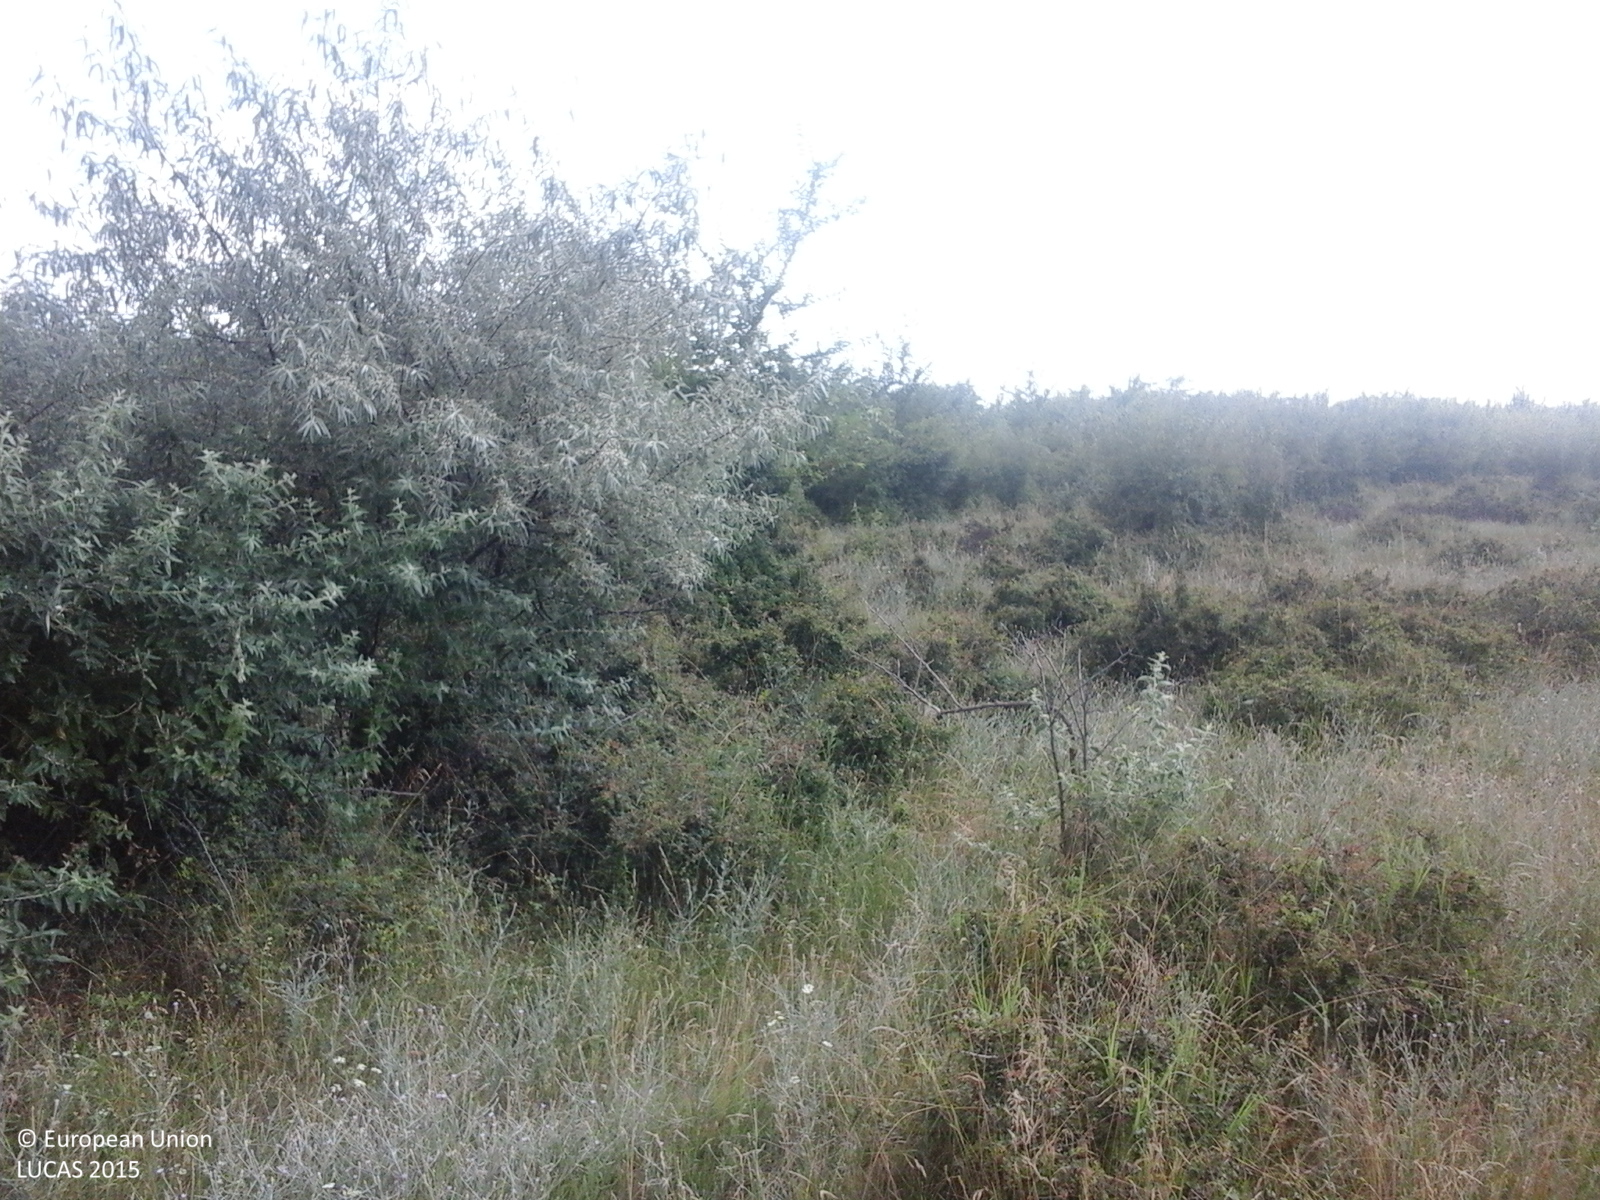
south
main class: Shrubland
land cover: Shrubland with sparse tree cover
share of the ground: > 75 %
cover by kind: shrubs 75 %, herbaceous plants 20 %, broadleaved forest trees 5 %
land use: Abandoned areas
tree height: < 5 m
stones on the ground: < 10 %
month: July
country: RO
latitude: 44.1718
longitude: 25.2287
